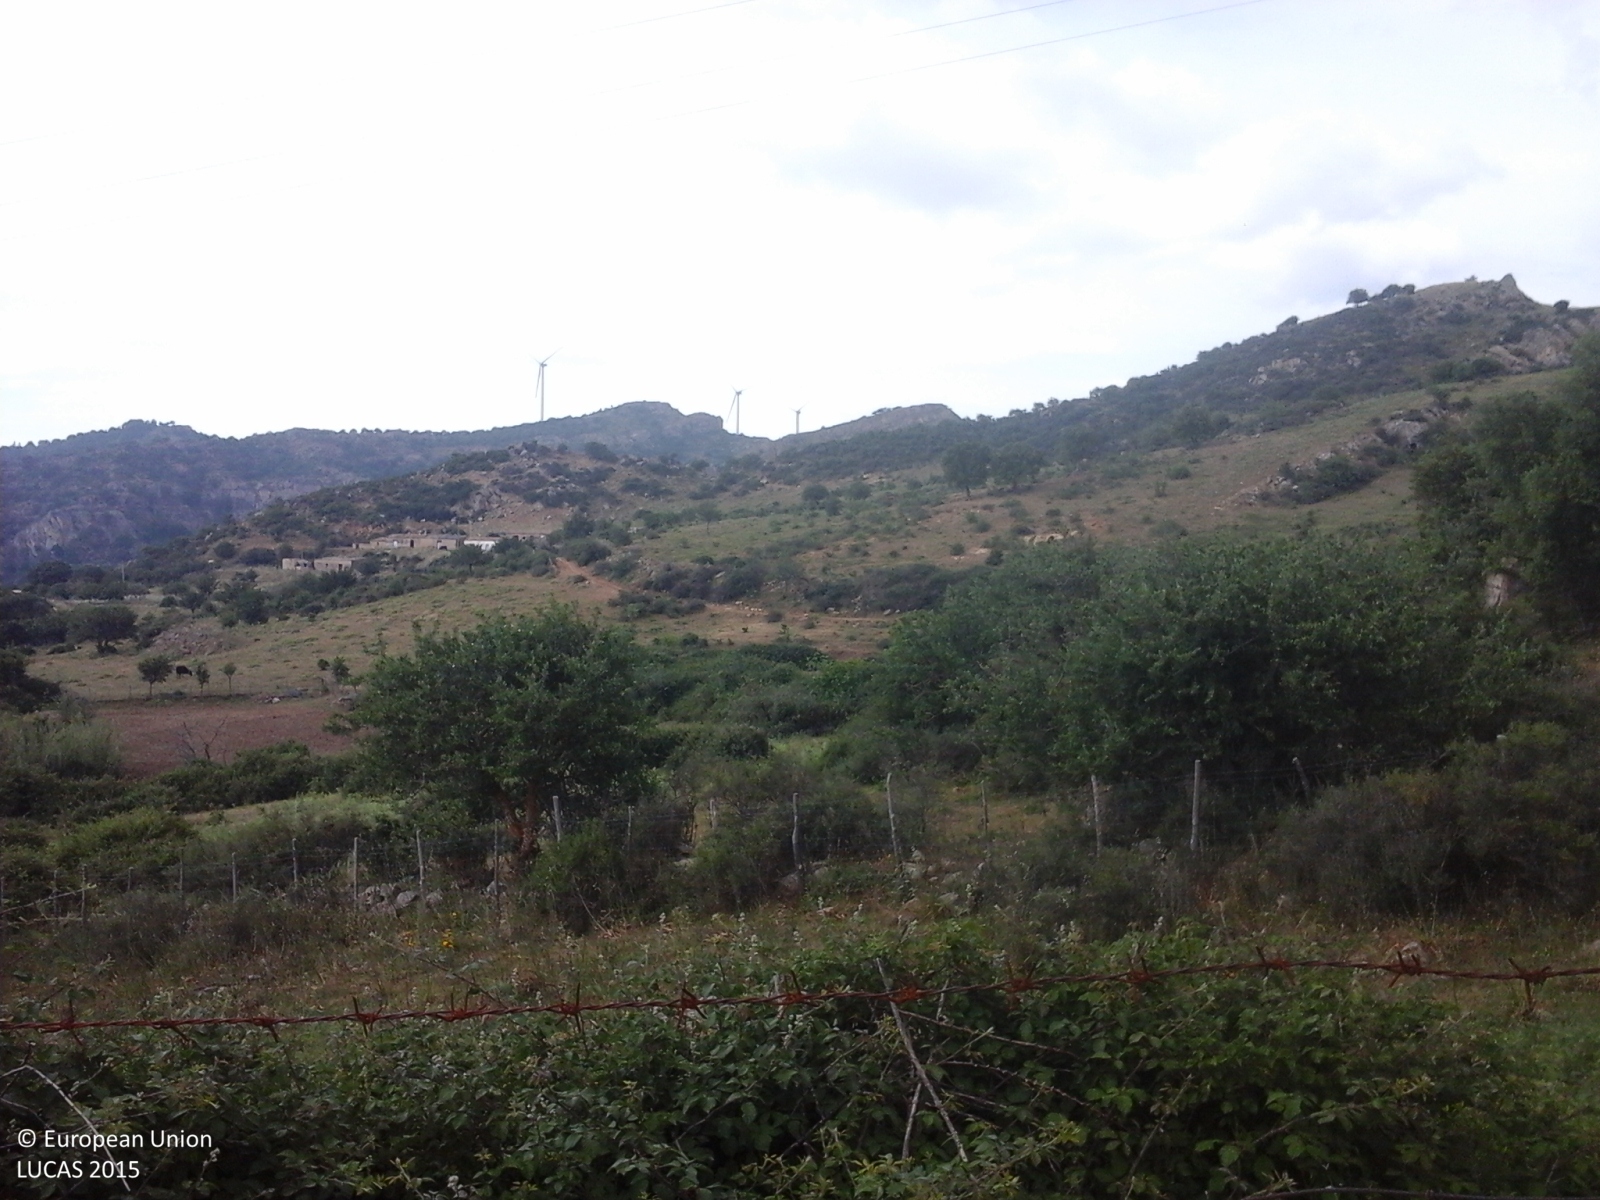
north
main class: Grassland
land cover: Grassland with sparse tree/shrub cover
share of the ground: > 75 %
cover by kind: herbaceous plants 80 %, shrubs 10 %, broadleaved forest trees 5 %, consolidated bare surface 5 %
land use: Agriculture (excluding fallow land and kitchen gardens)
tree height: > 5 m
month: June
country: IT
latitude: 37.7097
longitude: 14.5842
